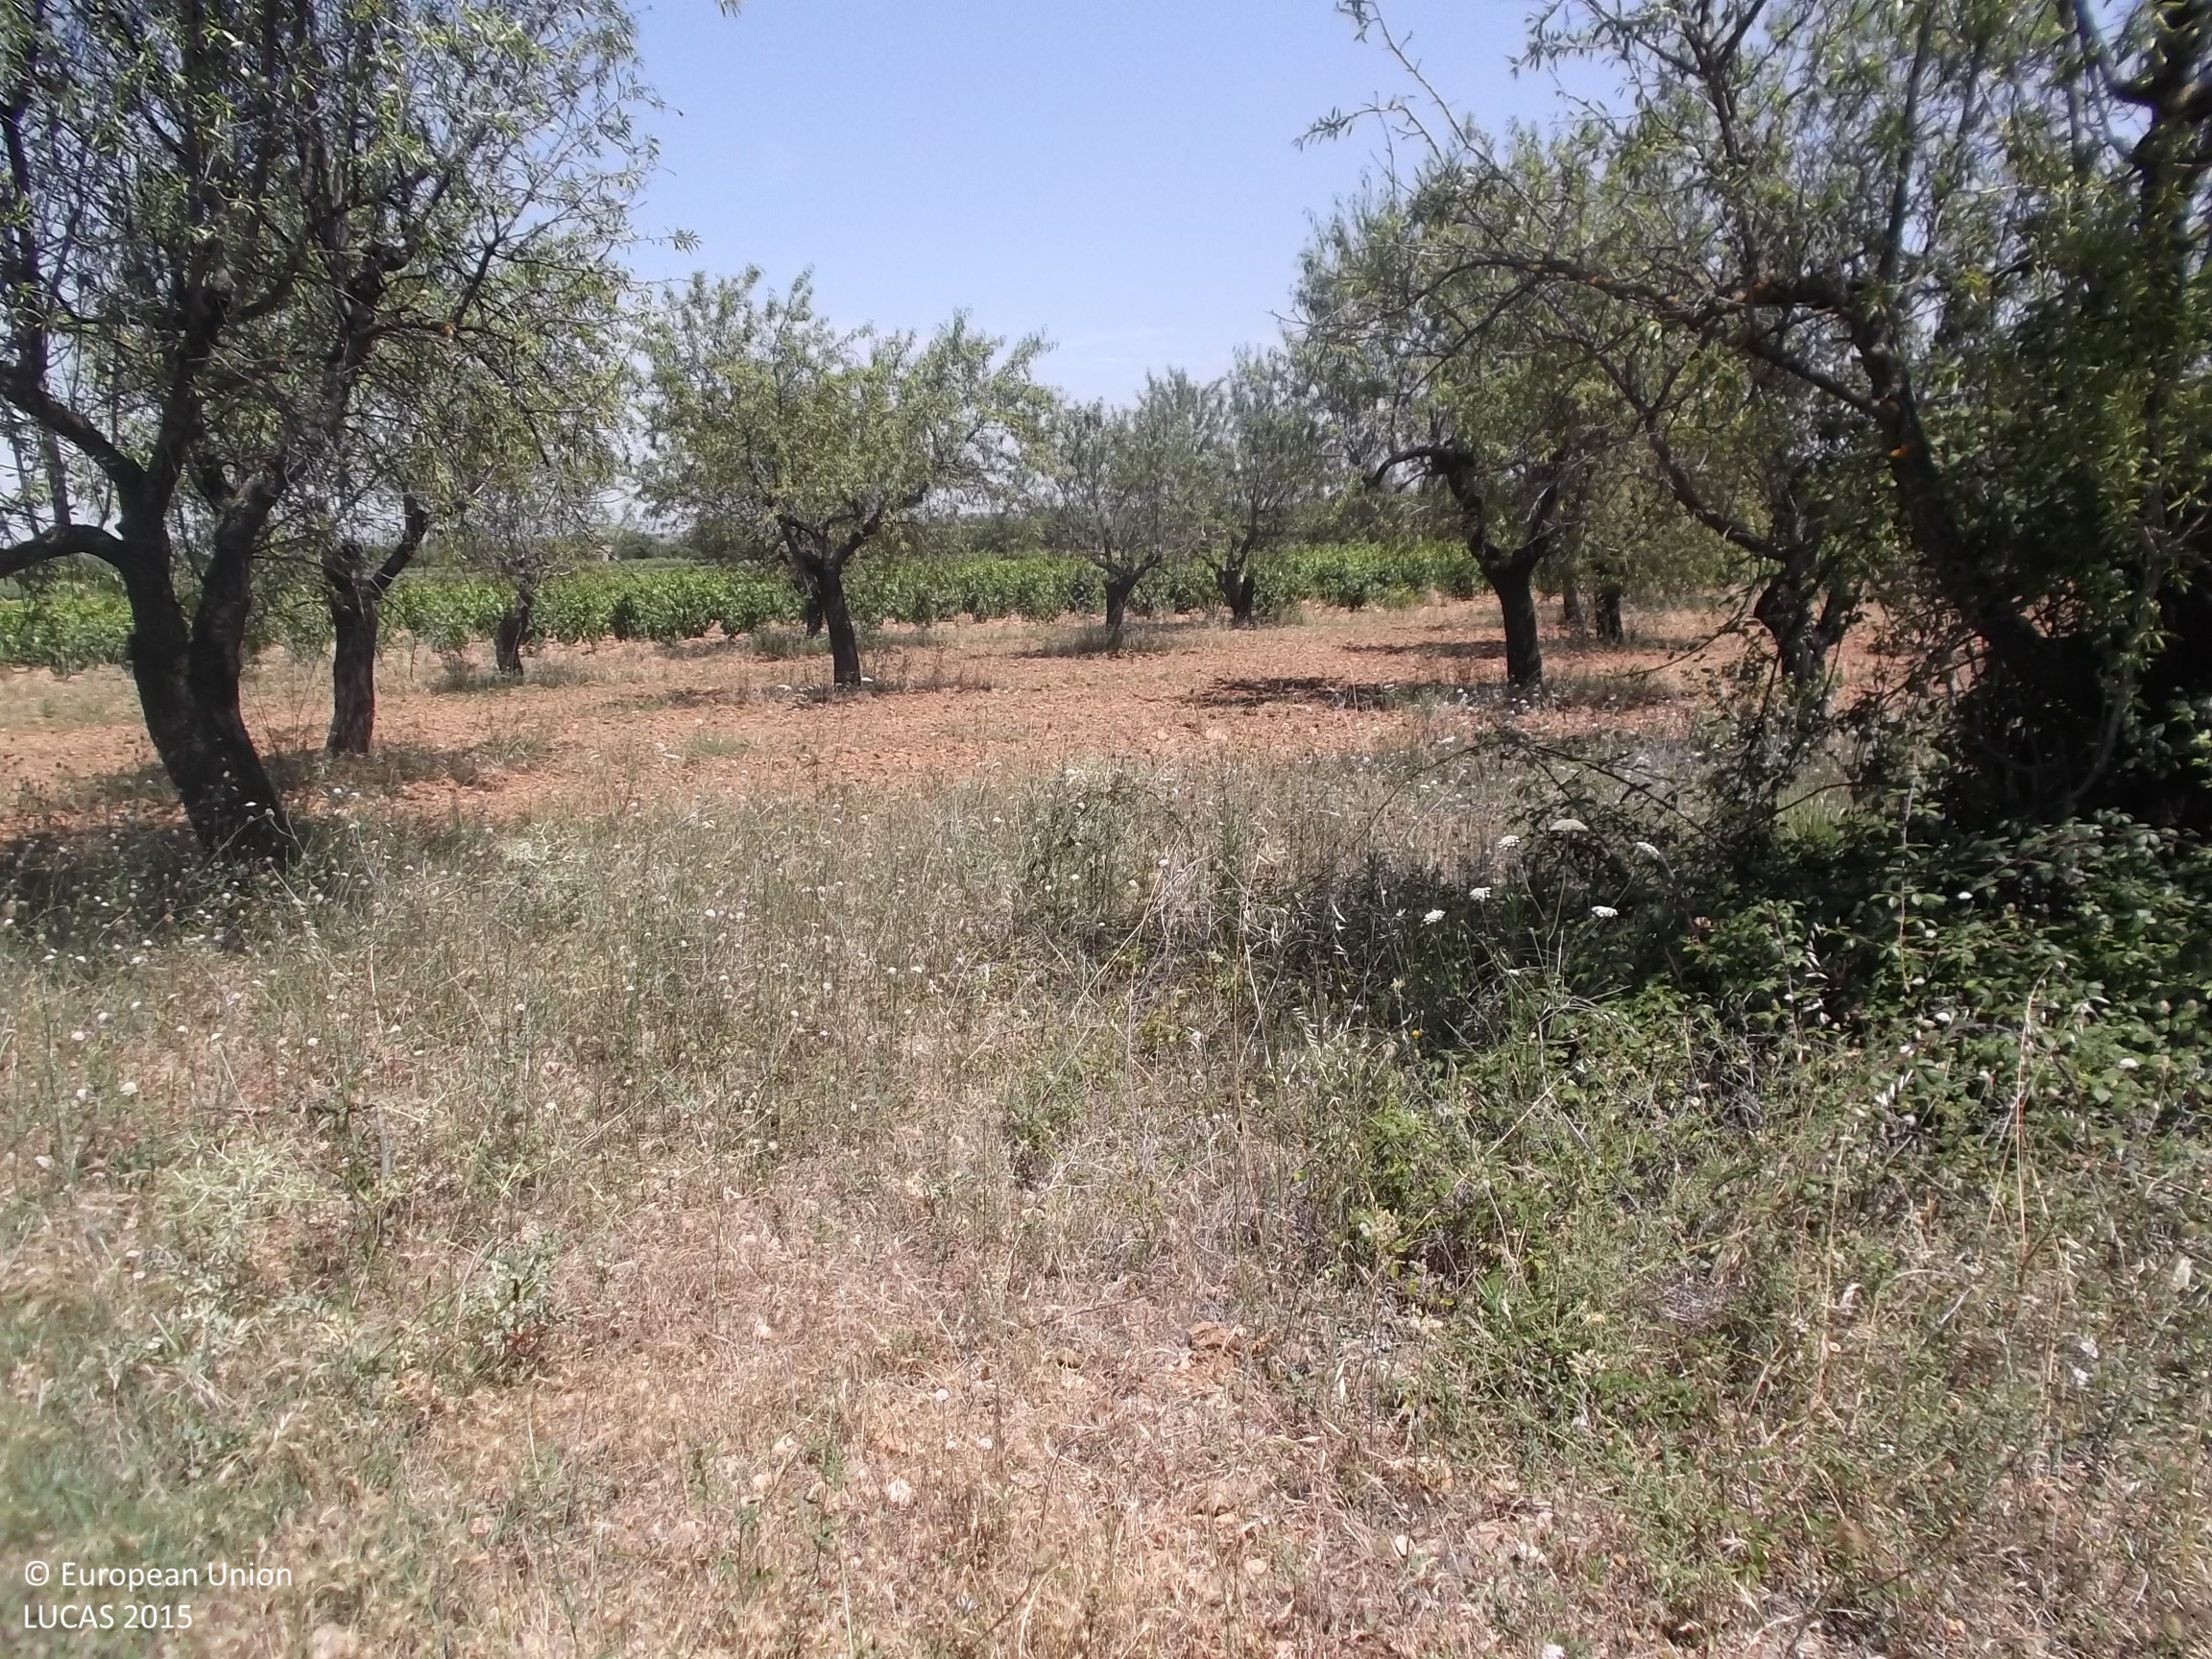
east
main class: Cropland
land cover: Nuts trees
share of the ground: 10 - 25 %
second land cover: Spontaneously vegetated surfaces
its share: > 75 %
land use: Agriculture (excluding fallow land and kitchen gardens)
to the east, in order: Nuts trees; Spontaneously vegetated surfaces; Vineyards; Barley; Grass margins; Tracks; Nuts trees
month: June
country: ES
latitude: 42.2927
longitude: -2.0826
